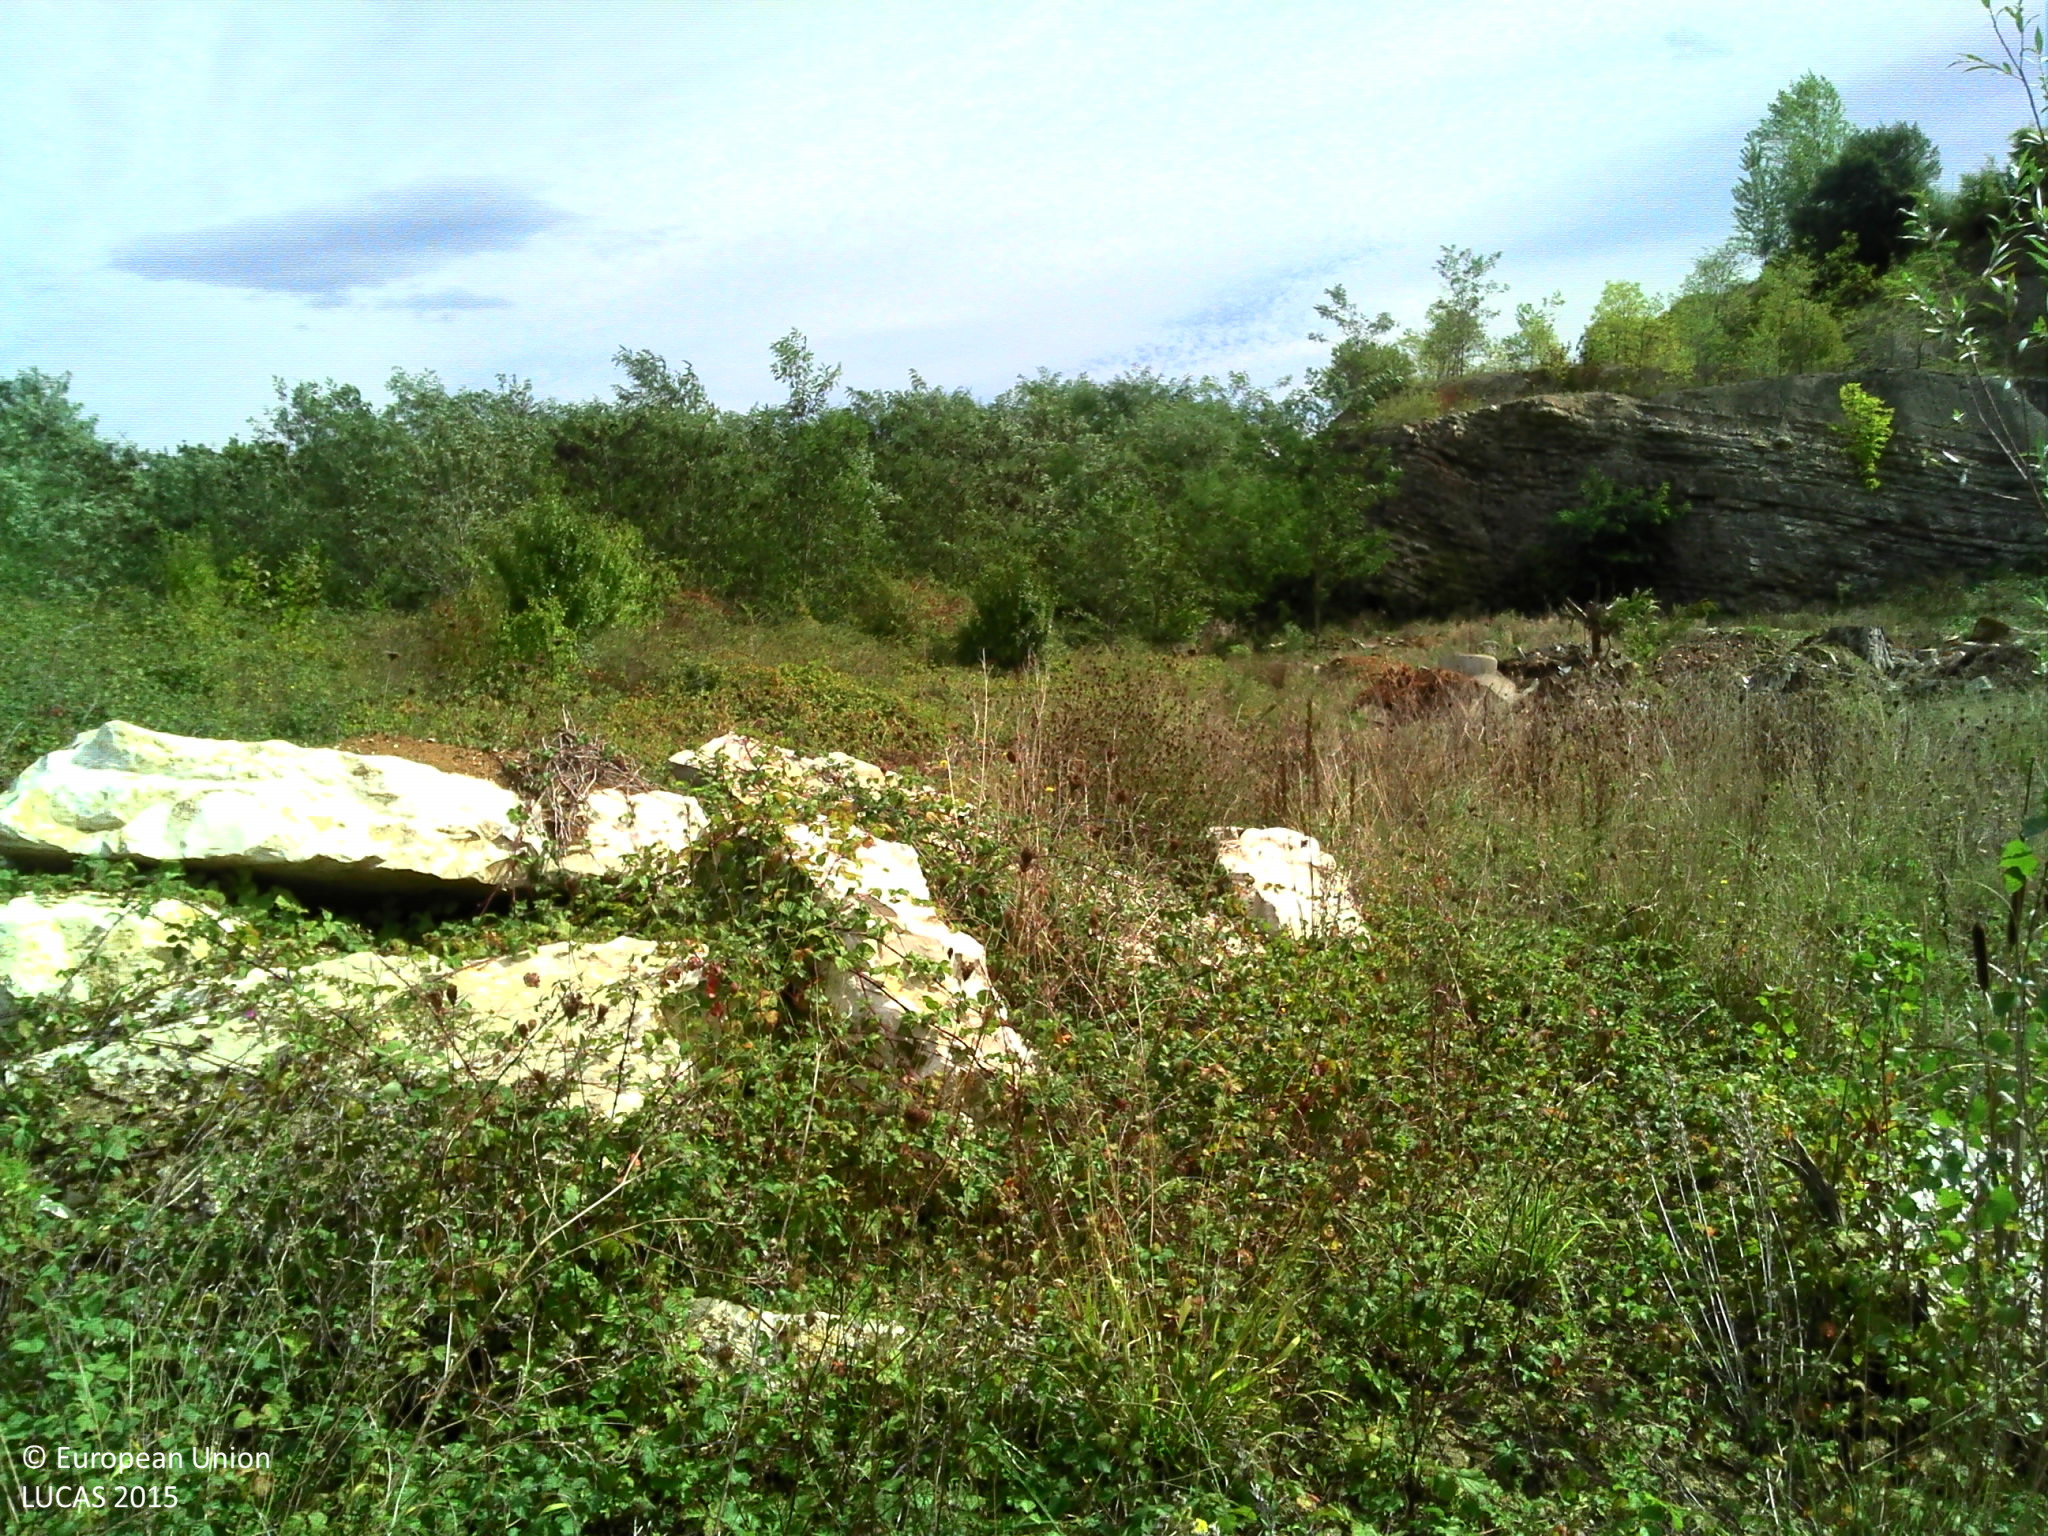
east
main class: Shrubland
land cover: Shrubland with sparse tree cover
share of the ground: > 75 %
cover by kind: shrubs 40 %, unconsolidated bare surface 30 %, herbaceous plants 20 %, broadleaved forest trees 5 %, consolidated bare surface 5 %
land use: Abandoned areas
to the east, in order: Shrubland with sparse tree cover; Spontaneously vegetated surfaces; Tracks; Shrubland with sparse tree cover; Tracks; Broadleaved woodland; Shrubland with sparse tree cover; Grassland with sparse tree/shrub cover; Grassland without tree/shrub cover; Shrubland with sparse tree cover
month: September
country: FR
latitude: 43.4273
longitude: -0.7453
